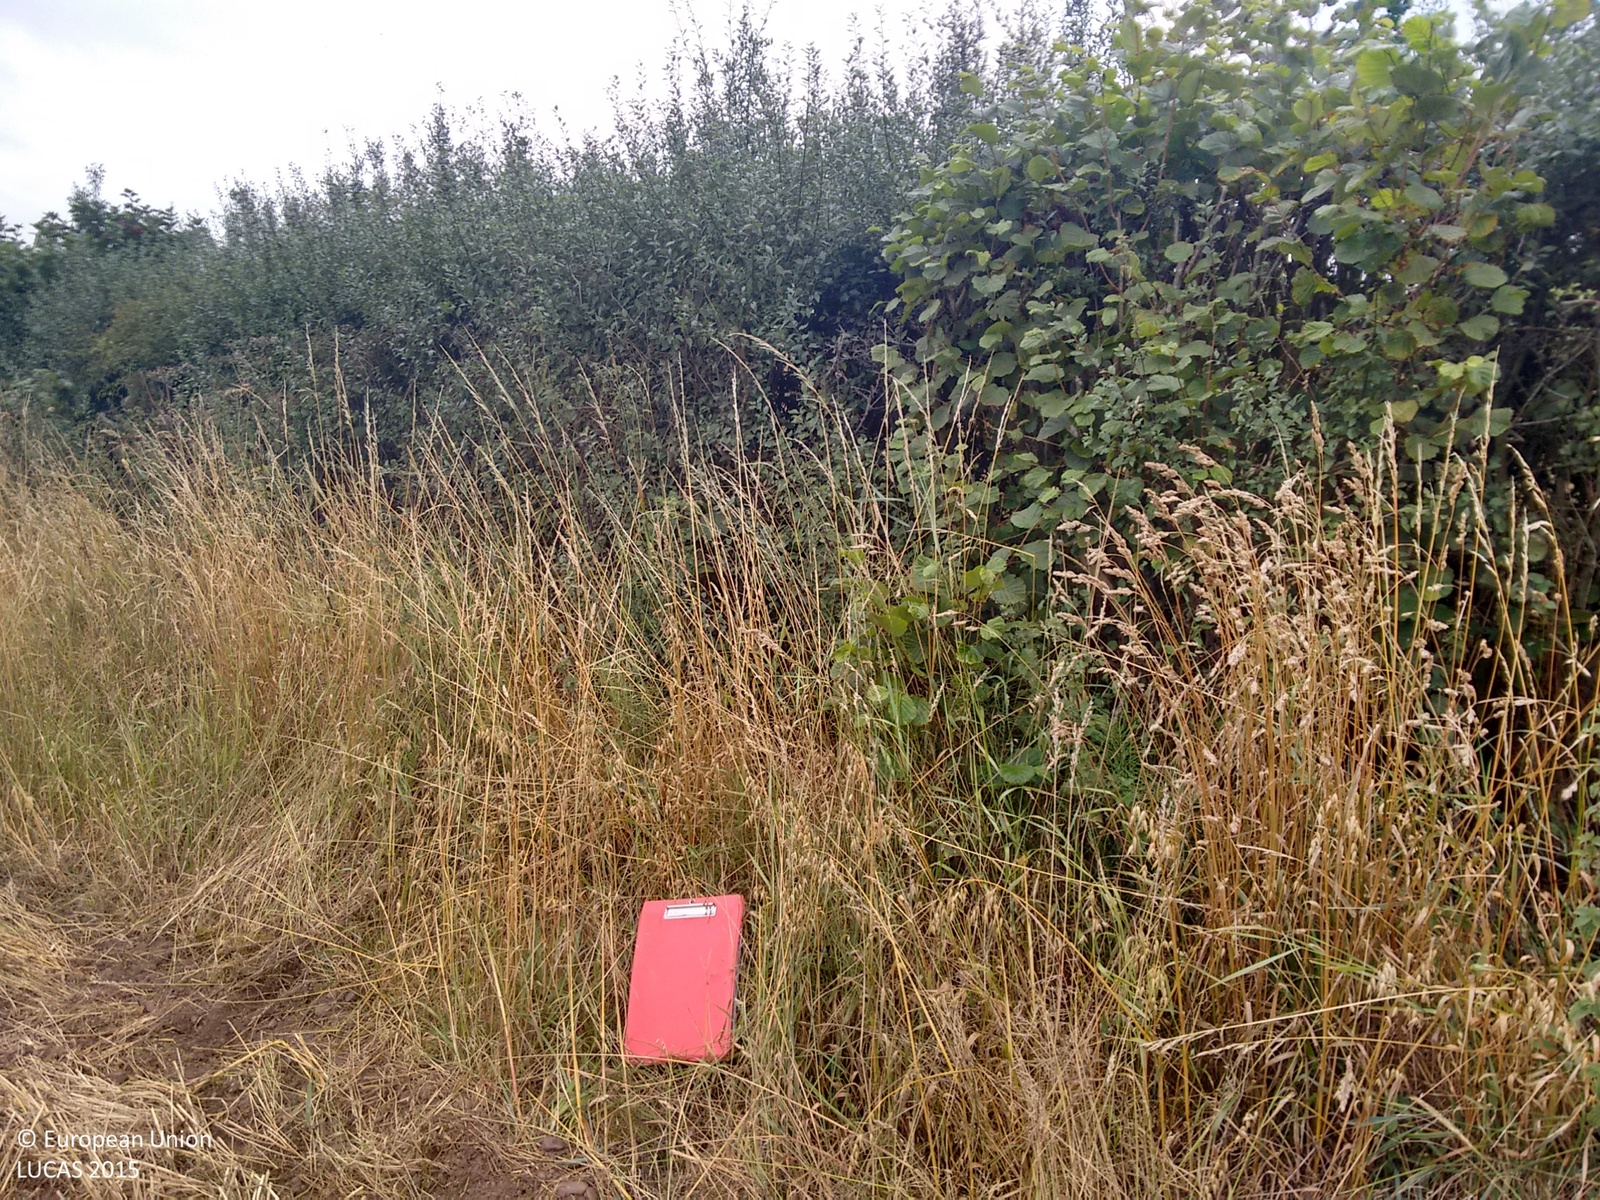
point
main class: Cropland
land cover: Common wheat
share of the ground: > 75 %
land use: Agriculture (excluding fallow land and kitchen gardens)
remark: Harvested field
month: August
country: GB
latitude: 52.8501
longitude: -2.7667
